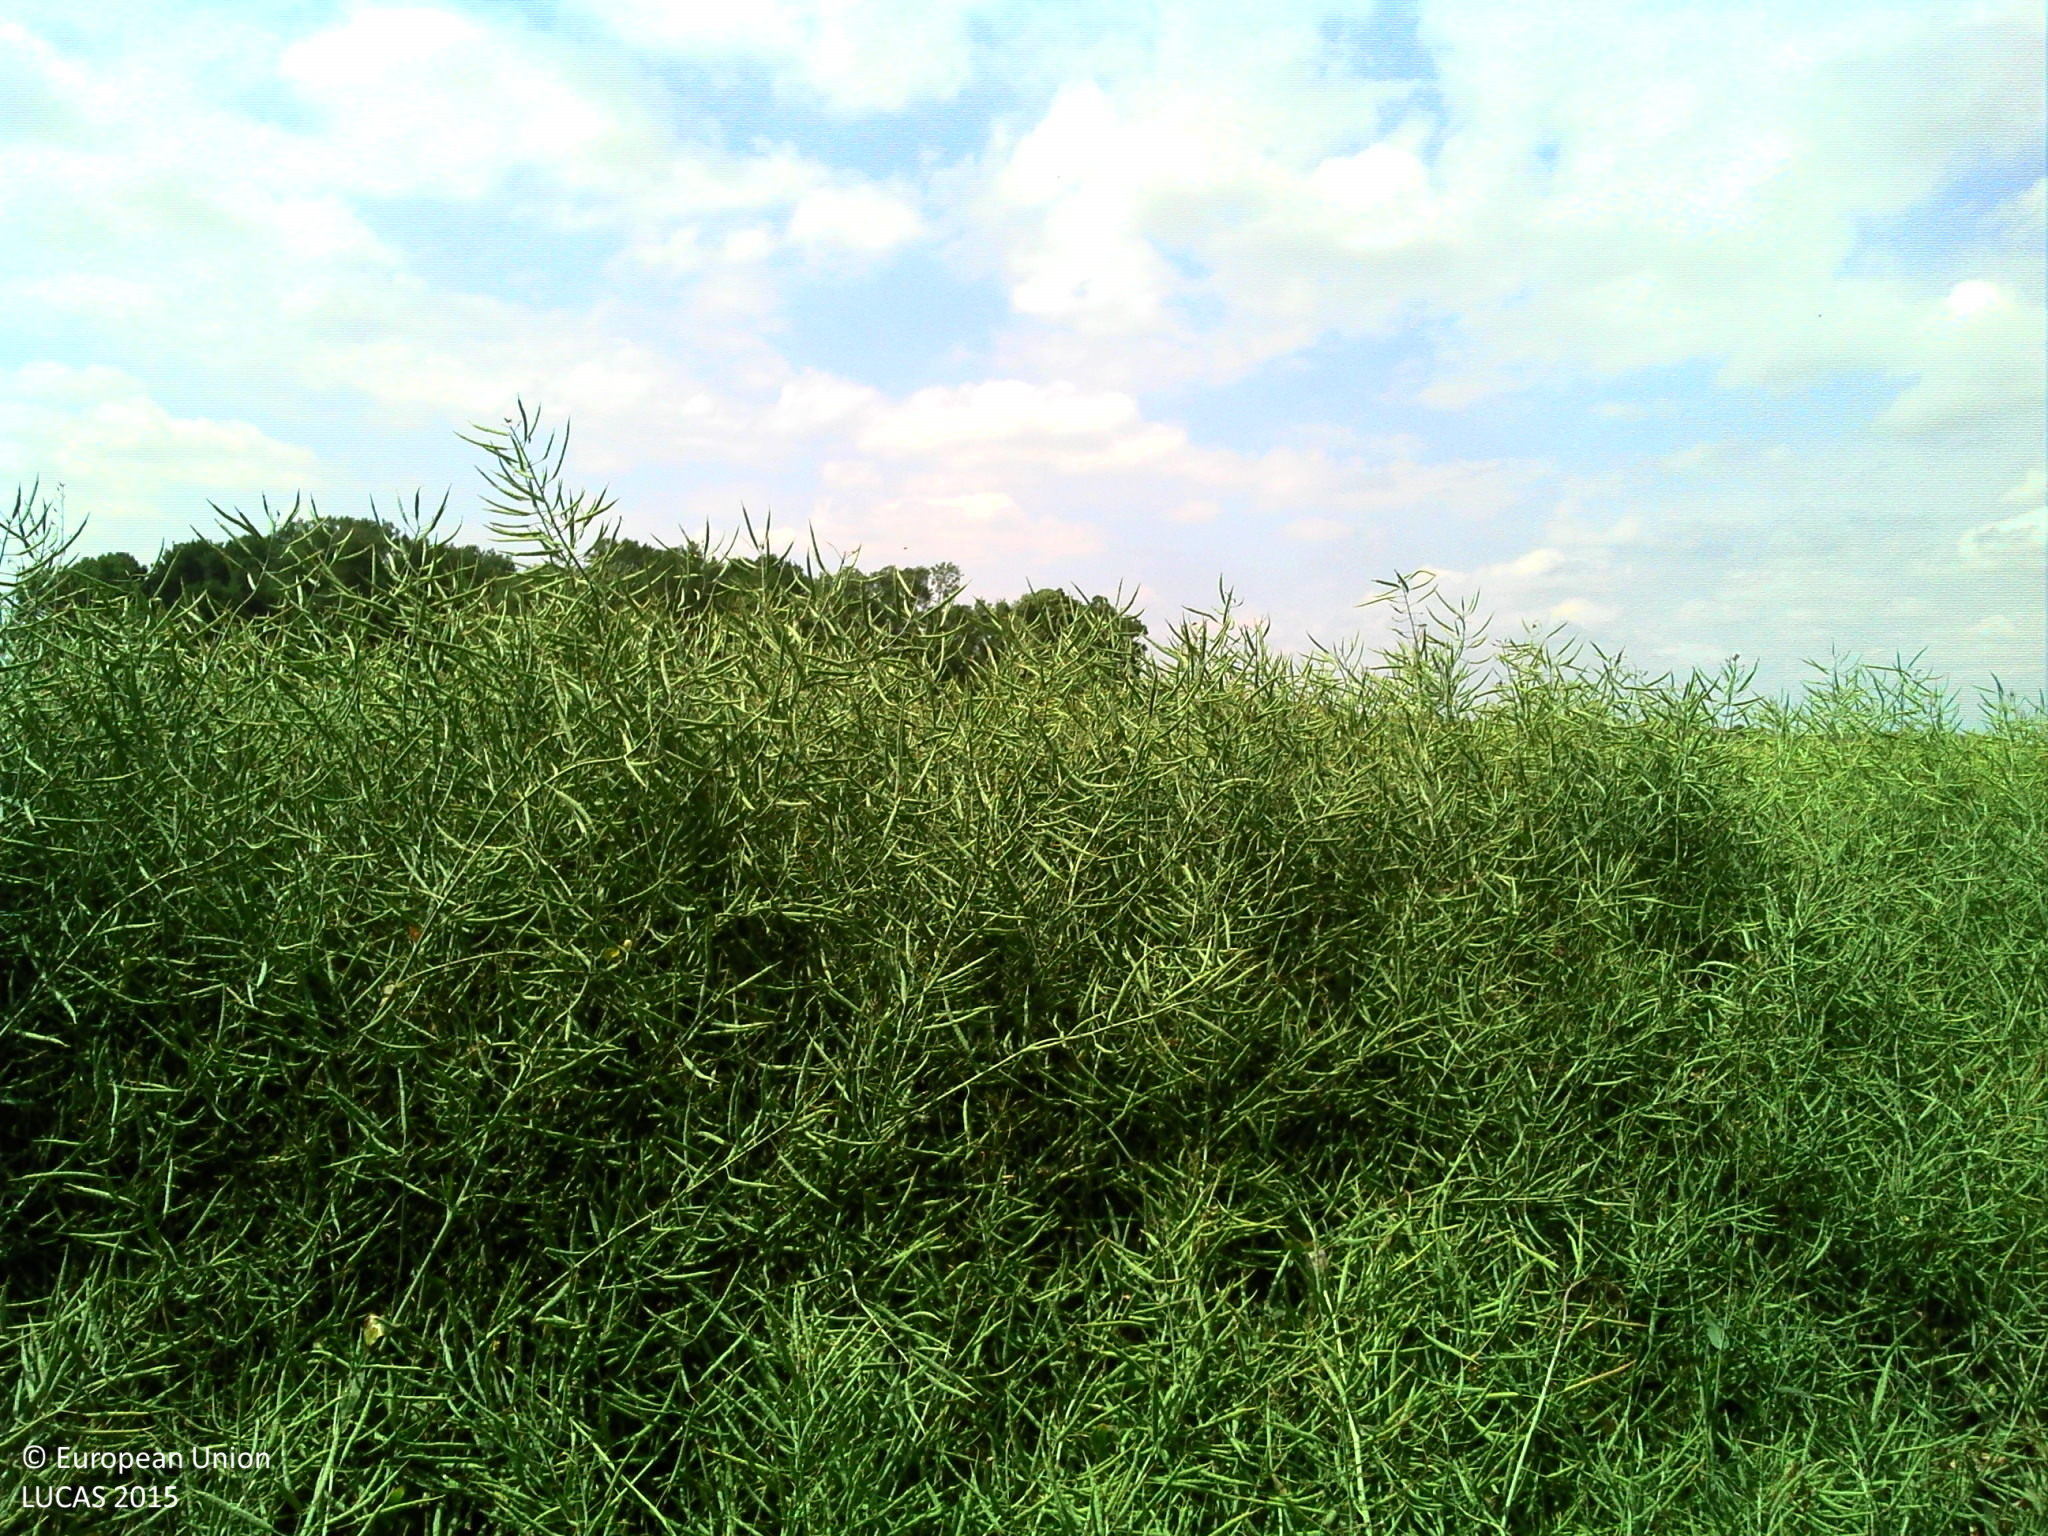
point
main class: Cropland
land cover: Rape and turnip rape
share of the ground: > 75 %
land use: Agriculture (excluding fallow land and kitchen gardens)
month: June
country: FR
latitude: 47.3303
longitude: 5.3032
